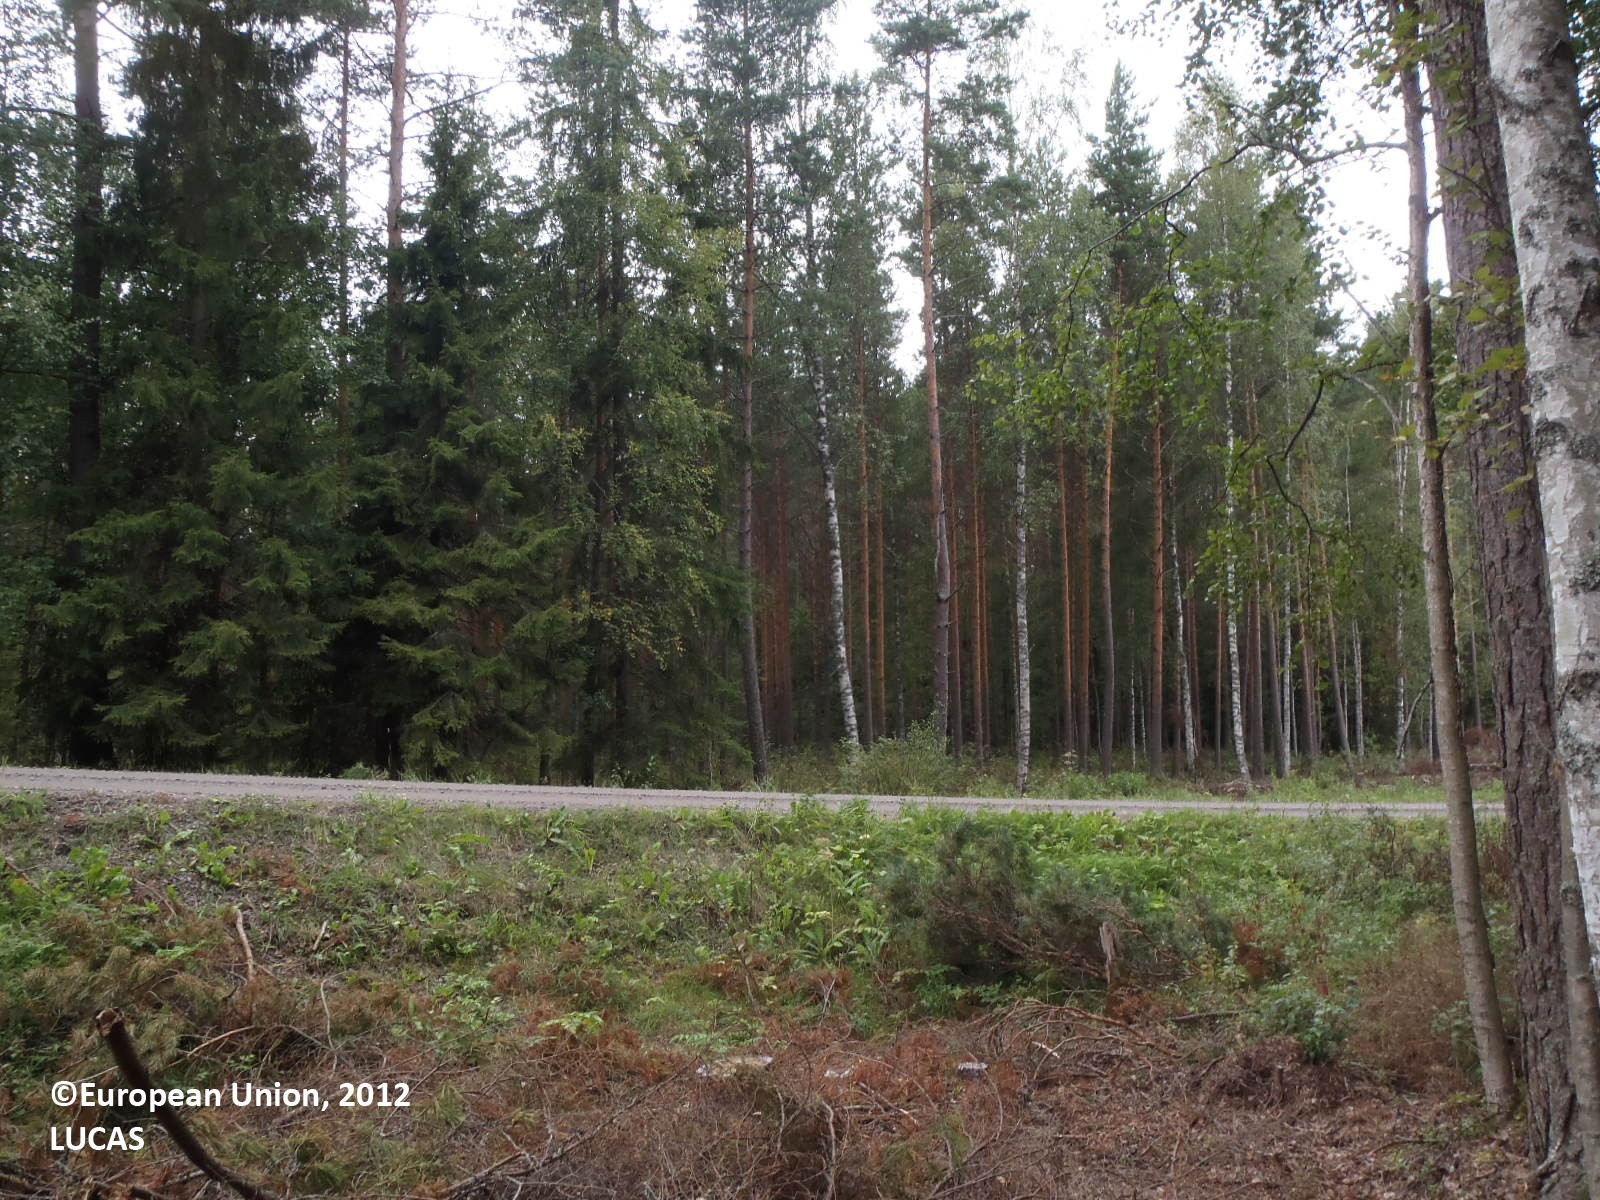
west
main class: Woodland
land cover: Pine dominated mixed woodland
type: boreal forest
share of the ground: > 75 %
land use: Forestry
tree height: > 5 m
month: August
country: FI
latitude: 60.8863
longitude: 22.2430
